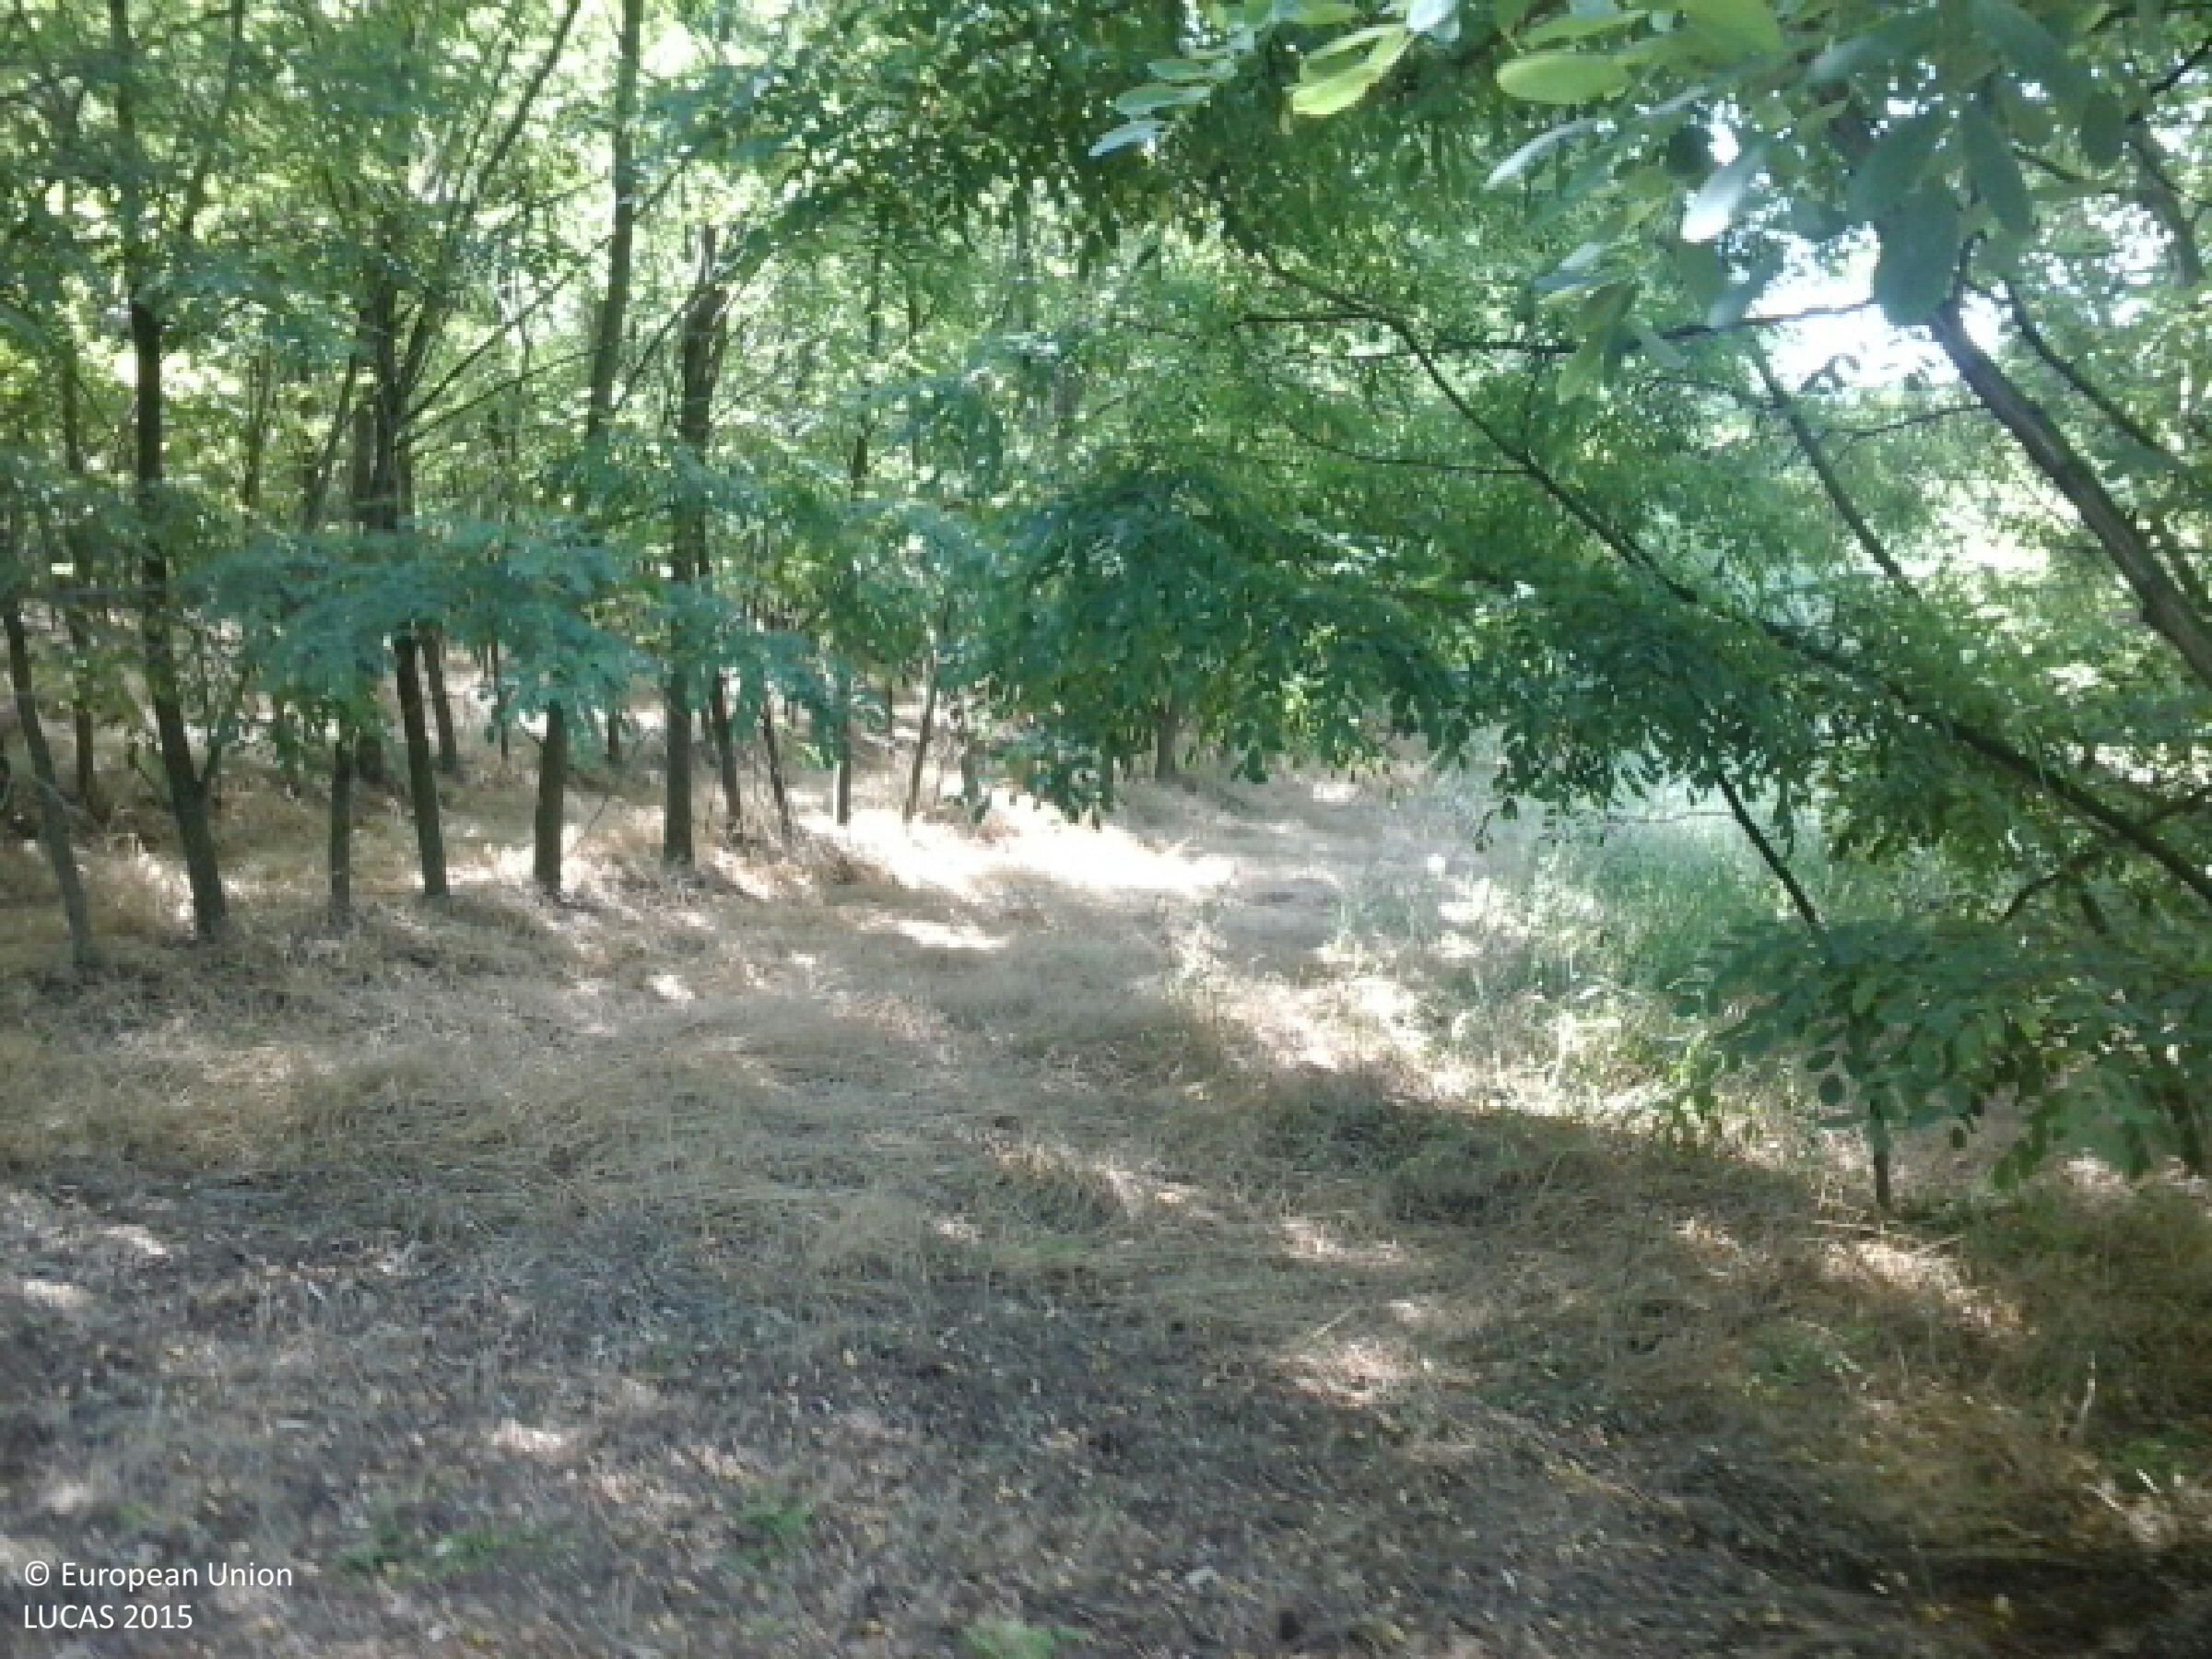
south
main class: Woodland
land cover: Broadleaved woodland
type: mesophytic deciduous forest
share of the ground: > 75 %
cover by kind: broadleaved forest trees 95 %, herbaceous plants 5 %
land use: Forestry
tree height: > 5 m
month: July
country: HU
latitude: 47.9554
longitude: 22.2548
